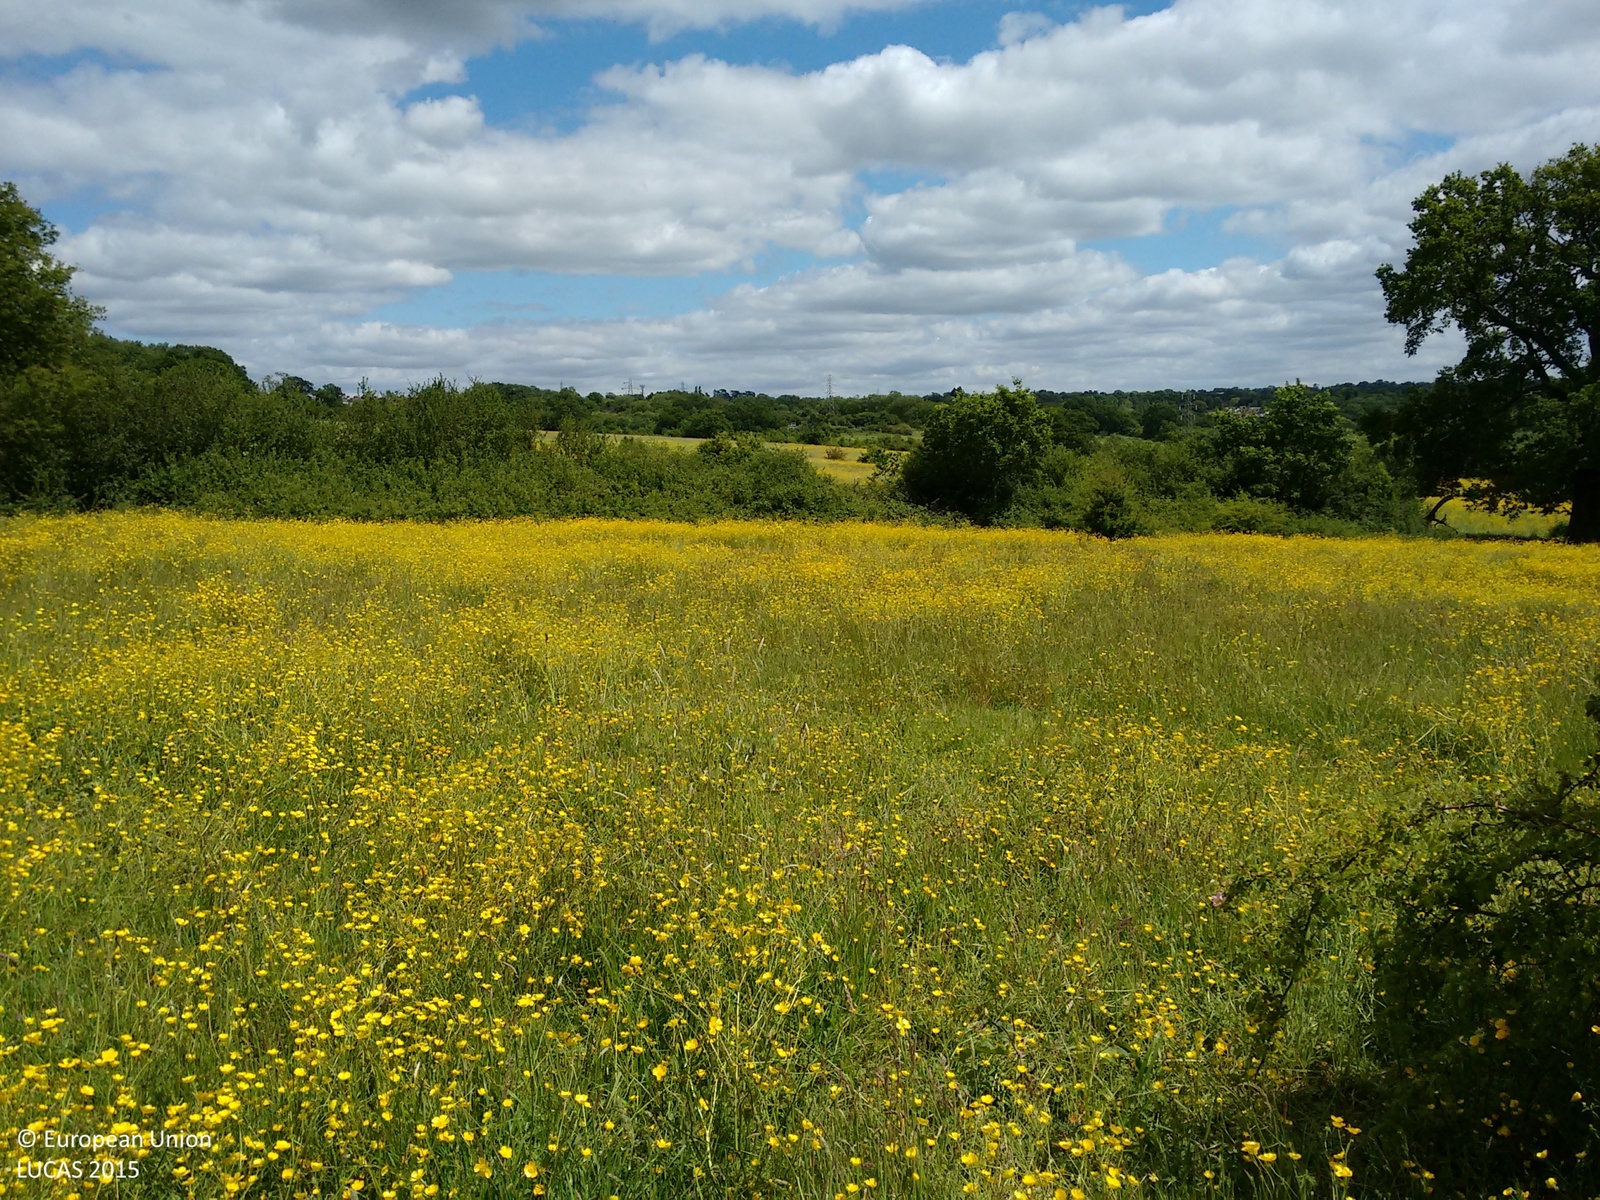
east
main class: Grassland
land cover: Grassland with sparse tree/shrub cover
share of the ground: > 75 %
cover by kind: herbaceous plants 95 %, broadleaved forest trees 5 %
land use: Agriculture (excluding fallow land and kitchen gardens)
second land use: Amenities, museums, leisure
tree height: < 5 m
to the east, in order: Grassland with sparse tree/shrub cover; Abandoned hedges; Grassland with sparse tree/shrub cover; Grassland without tree/shrub cover
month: June
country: GB
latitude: 51.6323
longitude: -0.3668
